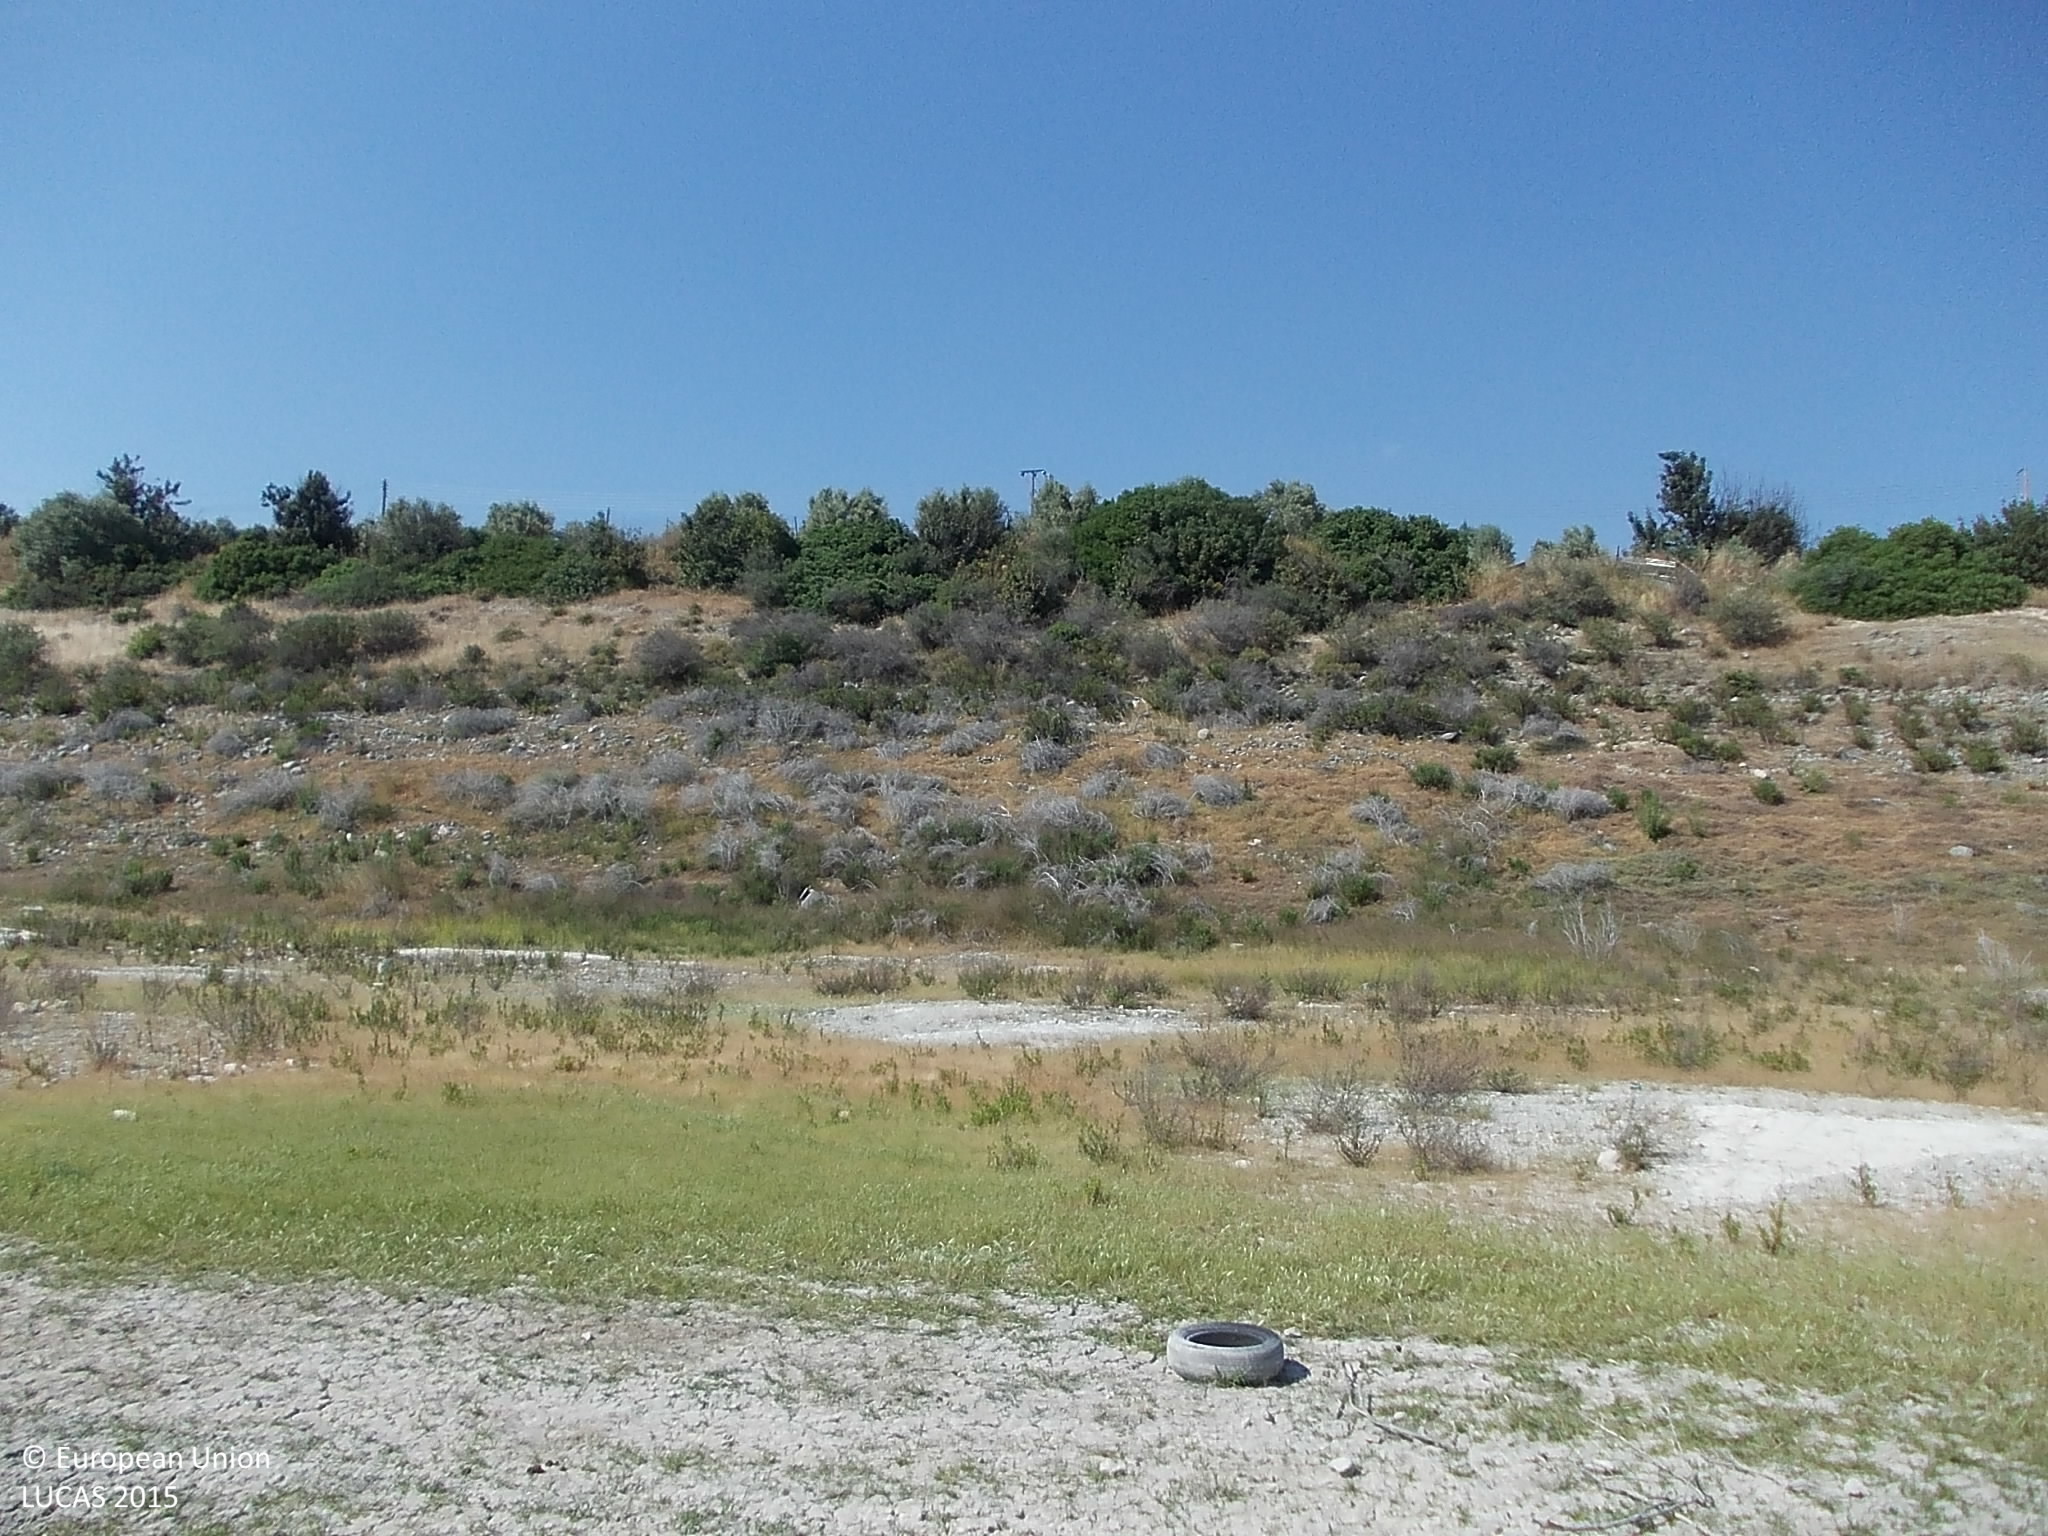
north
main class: Grassland
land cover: Grassland without tree/shrub cover
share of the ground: > 75 %
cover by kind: herbaceous plants 75 %, unconsolidated bare surface 25 %
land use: Semi-natural and natural areas not in use
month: May
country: CY
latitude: 34.7584
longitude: 32.9189
